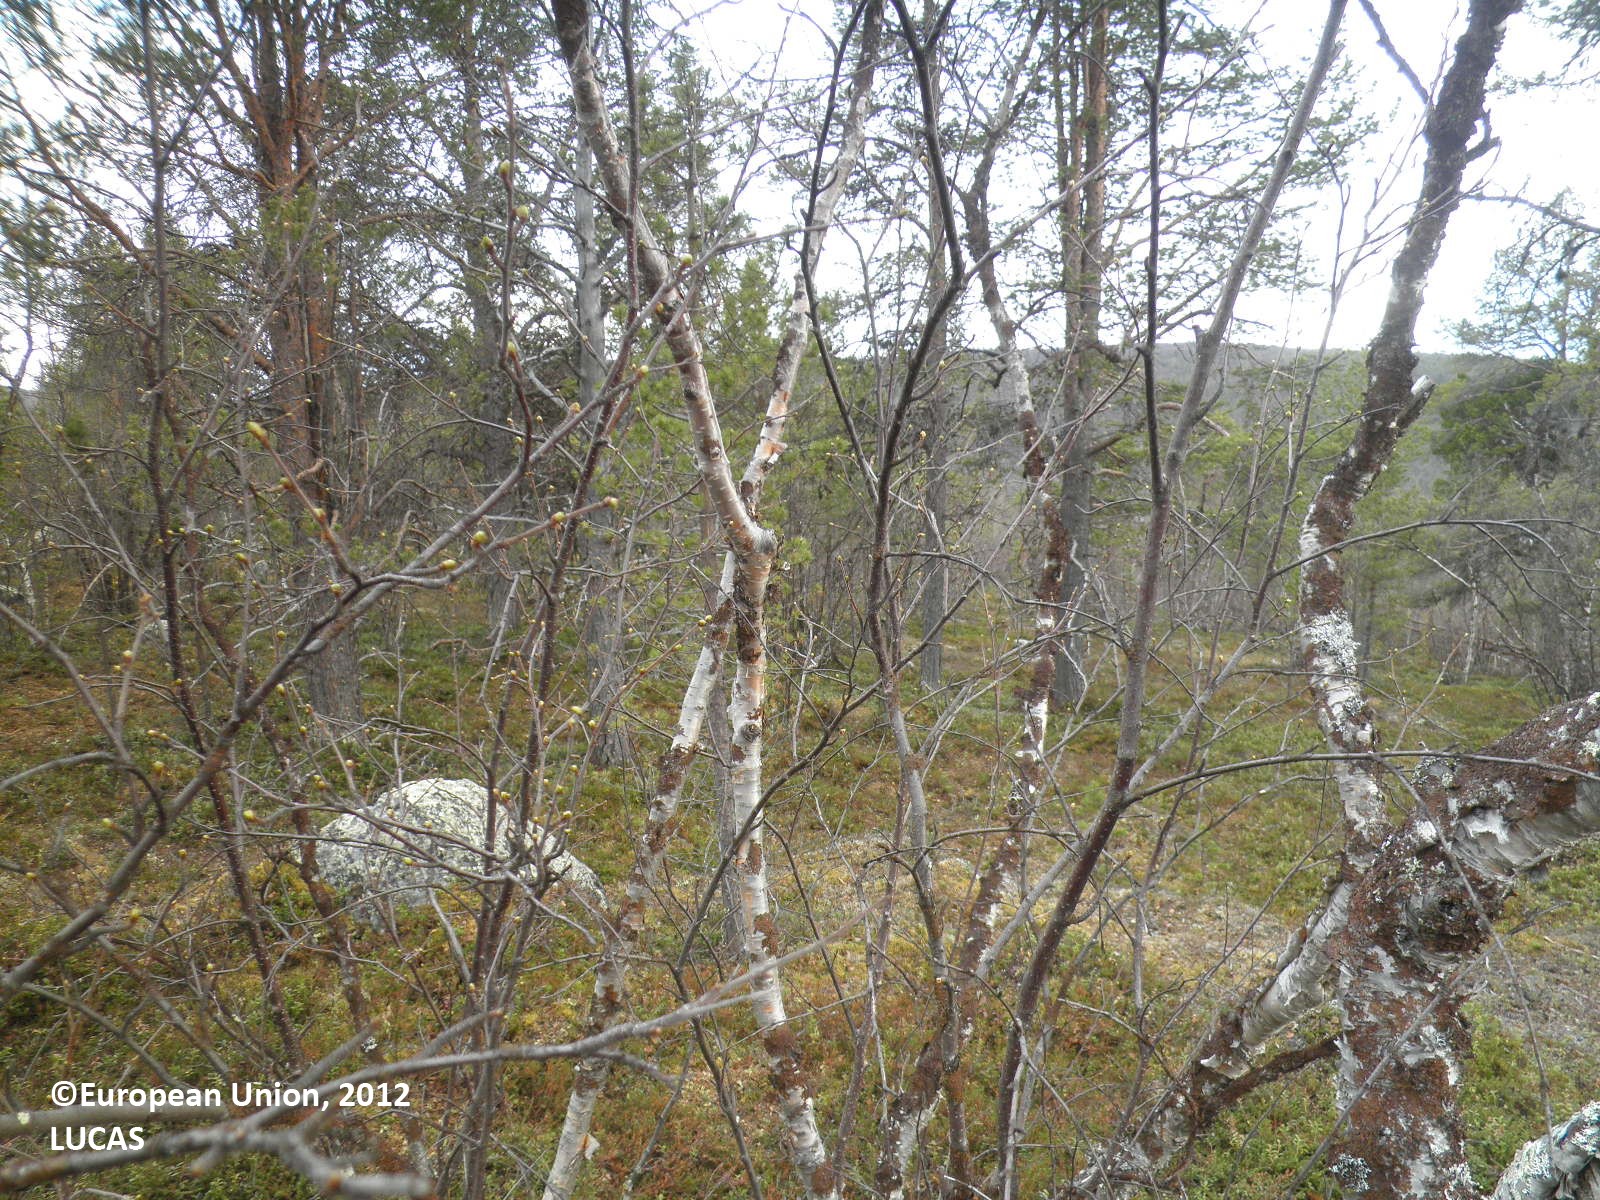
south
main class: Woodland
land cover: Pine dominated mixed woodland
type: boreal forest
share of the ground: > 75 %
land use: Forestry
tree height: > 5 m
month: May
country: FI
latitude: 69.7331
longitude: 27.0396
